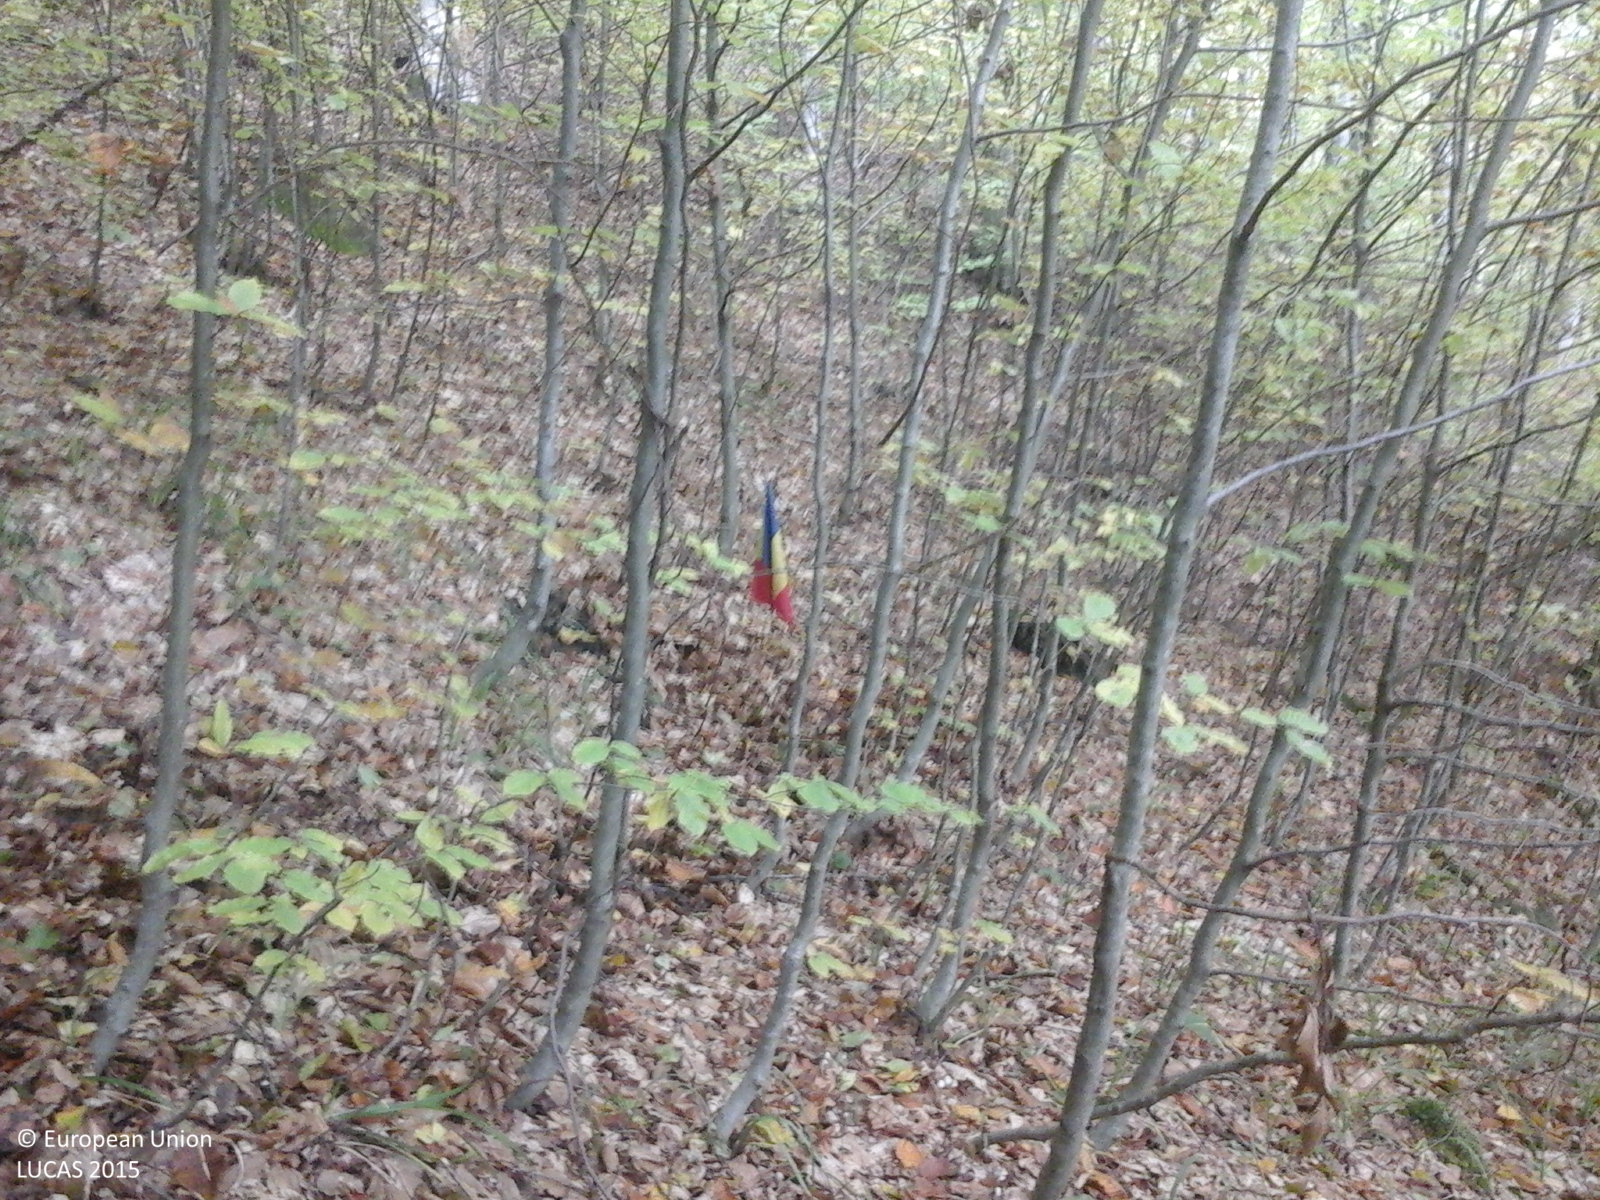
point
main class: Woodland
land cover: Broadleaved woodland
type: beech forest
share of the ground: > 75 %
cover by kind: broadleaved forest trees 100 %
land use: Forestry
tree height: > 5 m
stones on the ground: 10 - 25 %
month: October
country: RO
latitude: 46.5859
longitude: 25.2558
